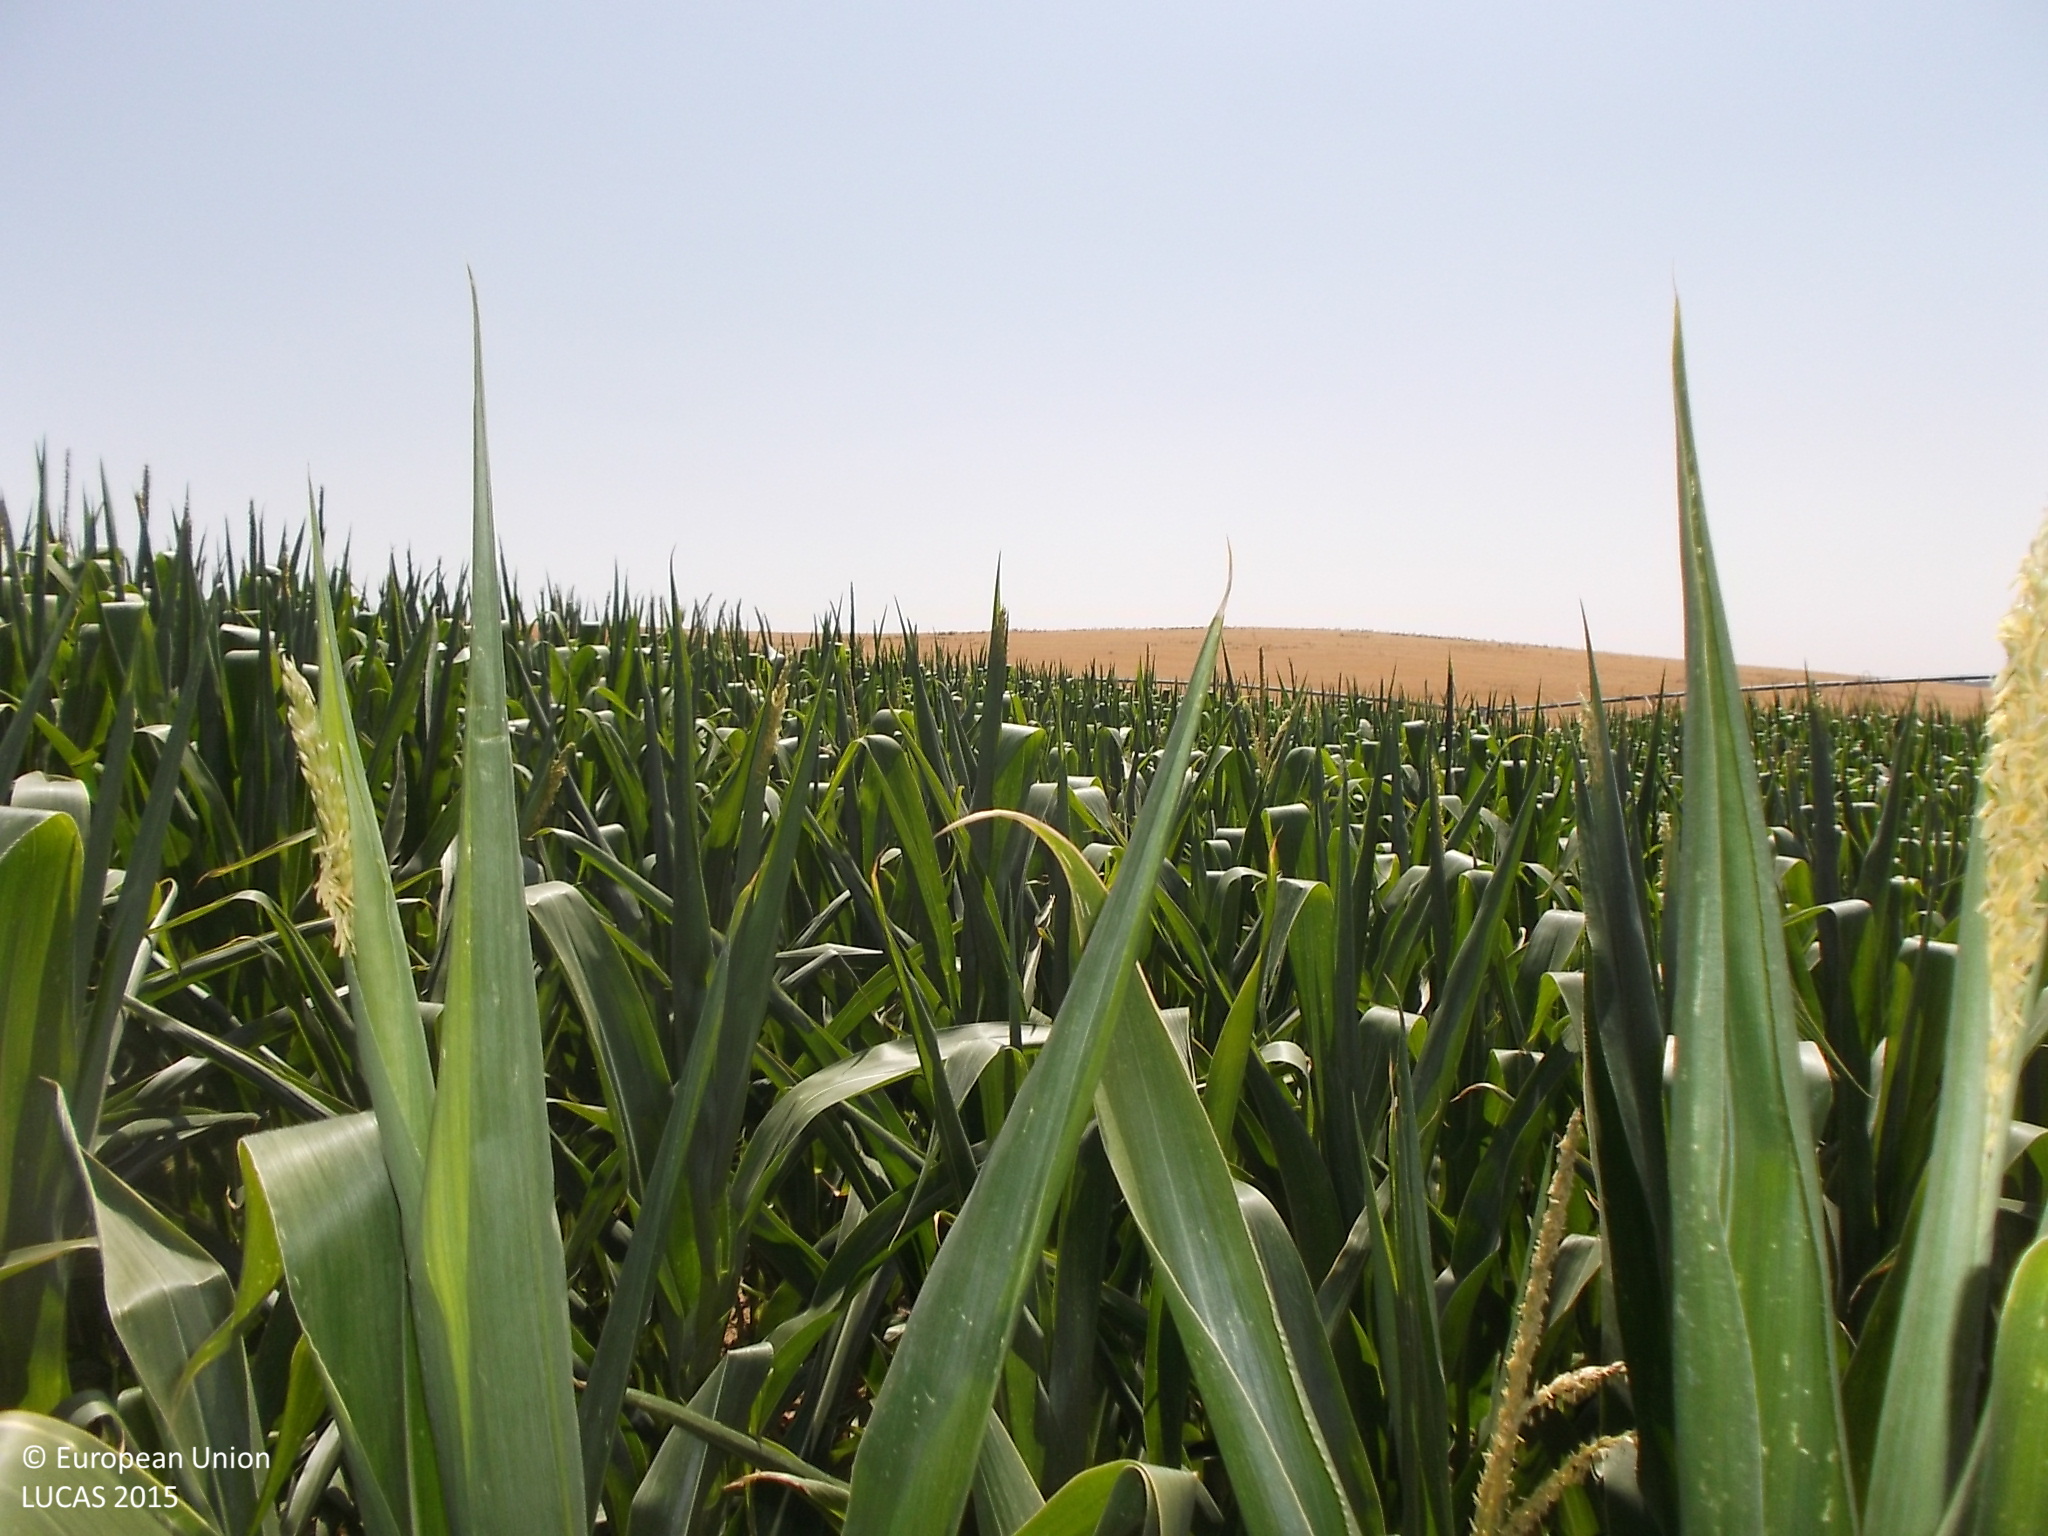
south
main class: Cropland
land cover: Maize
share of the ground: > 75 %
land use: Agriculture (excluding fallow land and kitchen gardens)
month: July
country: ES
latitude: 41.5611
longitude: -5.3924
